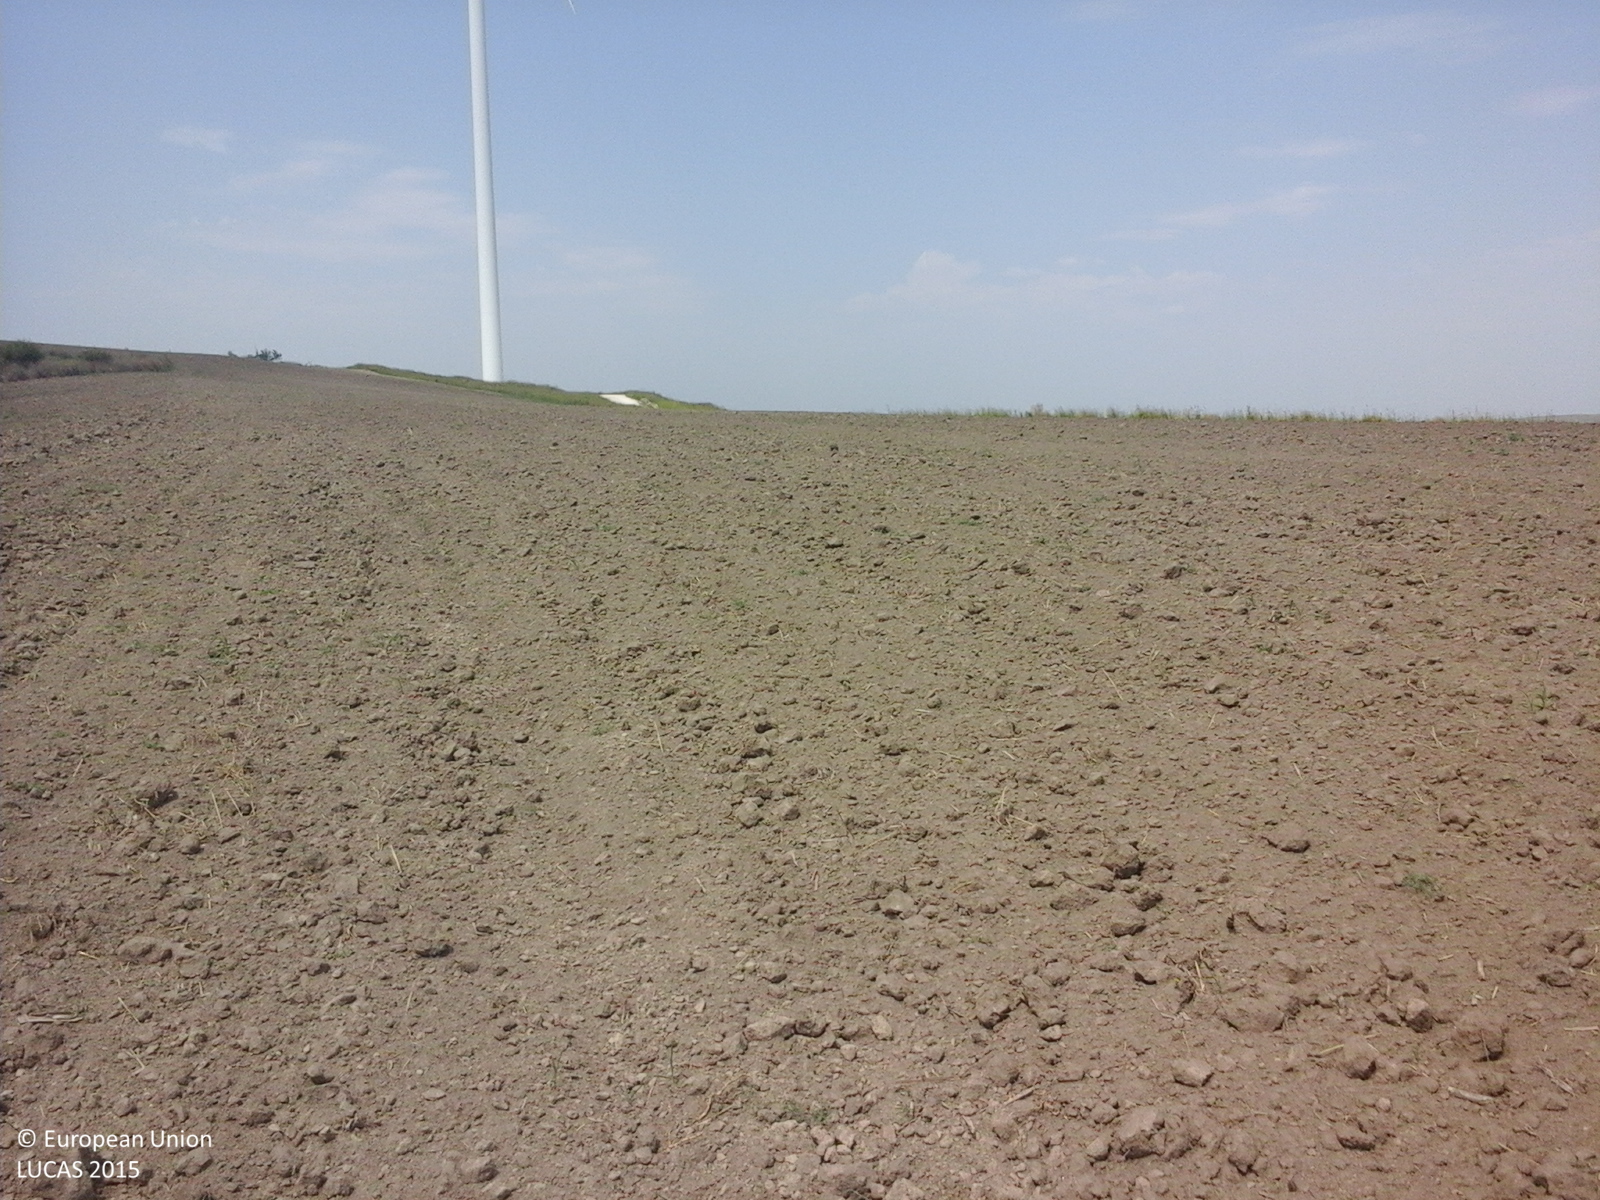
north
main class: Cropland
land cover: Common wheat
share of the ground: < 10 %
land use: Agriculture (excluding fallow land and kitchen gardens)
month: August
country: RO
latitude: 44.2149
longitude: 28.0155
